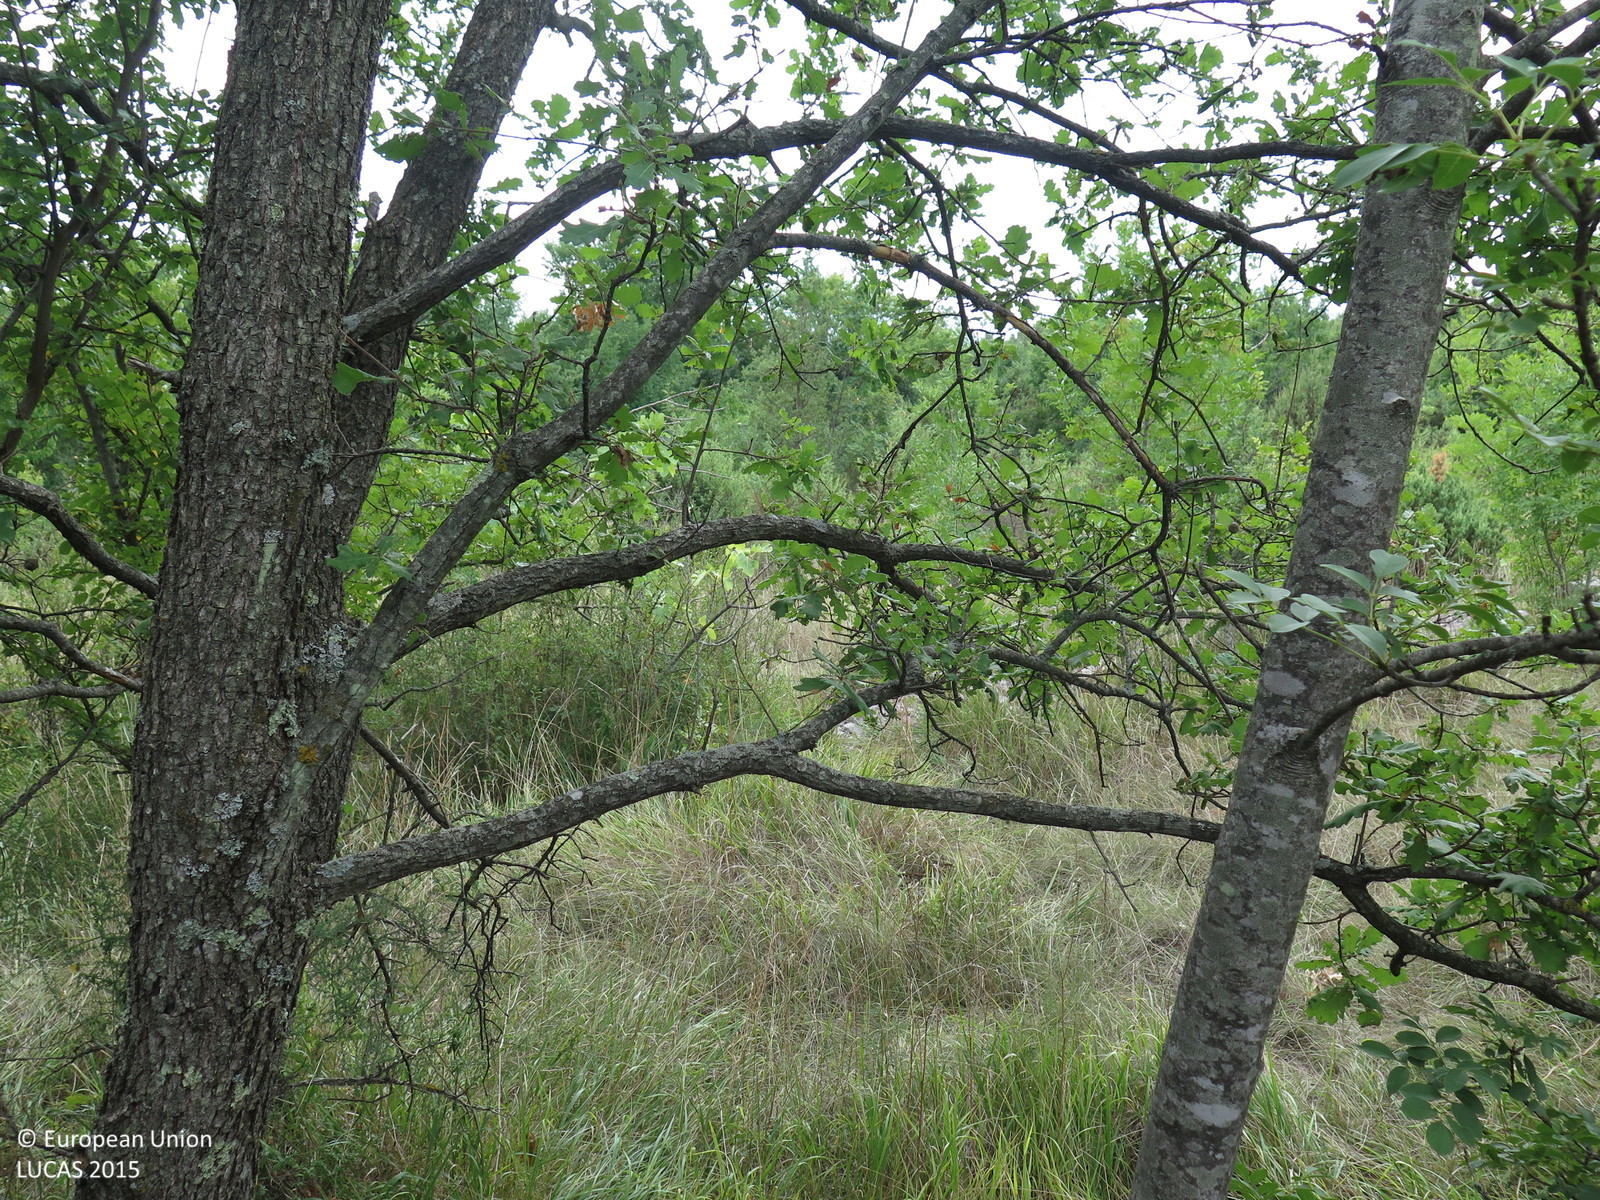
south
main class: Woodland
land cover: Broadleaved woodland
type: thermophilous deciduous forest
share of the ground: > 75 %
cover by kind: broadleaved forest trees 90 %, shrubs 5 %, herbaceous plants 5 %
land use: Abandoned areas
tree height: < 5 m
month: August
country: HR
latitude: 45.1307
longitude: 14.6609
